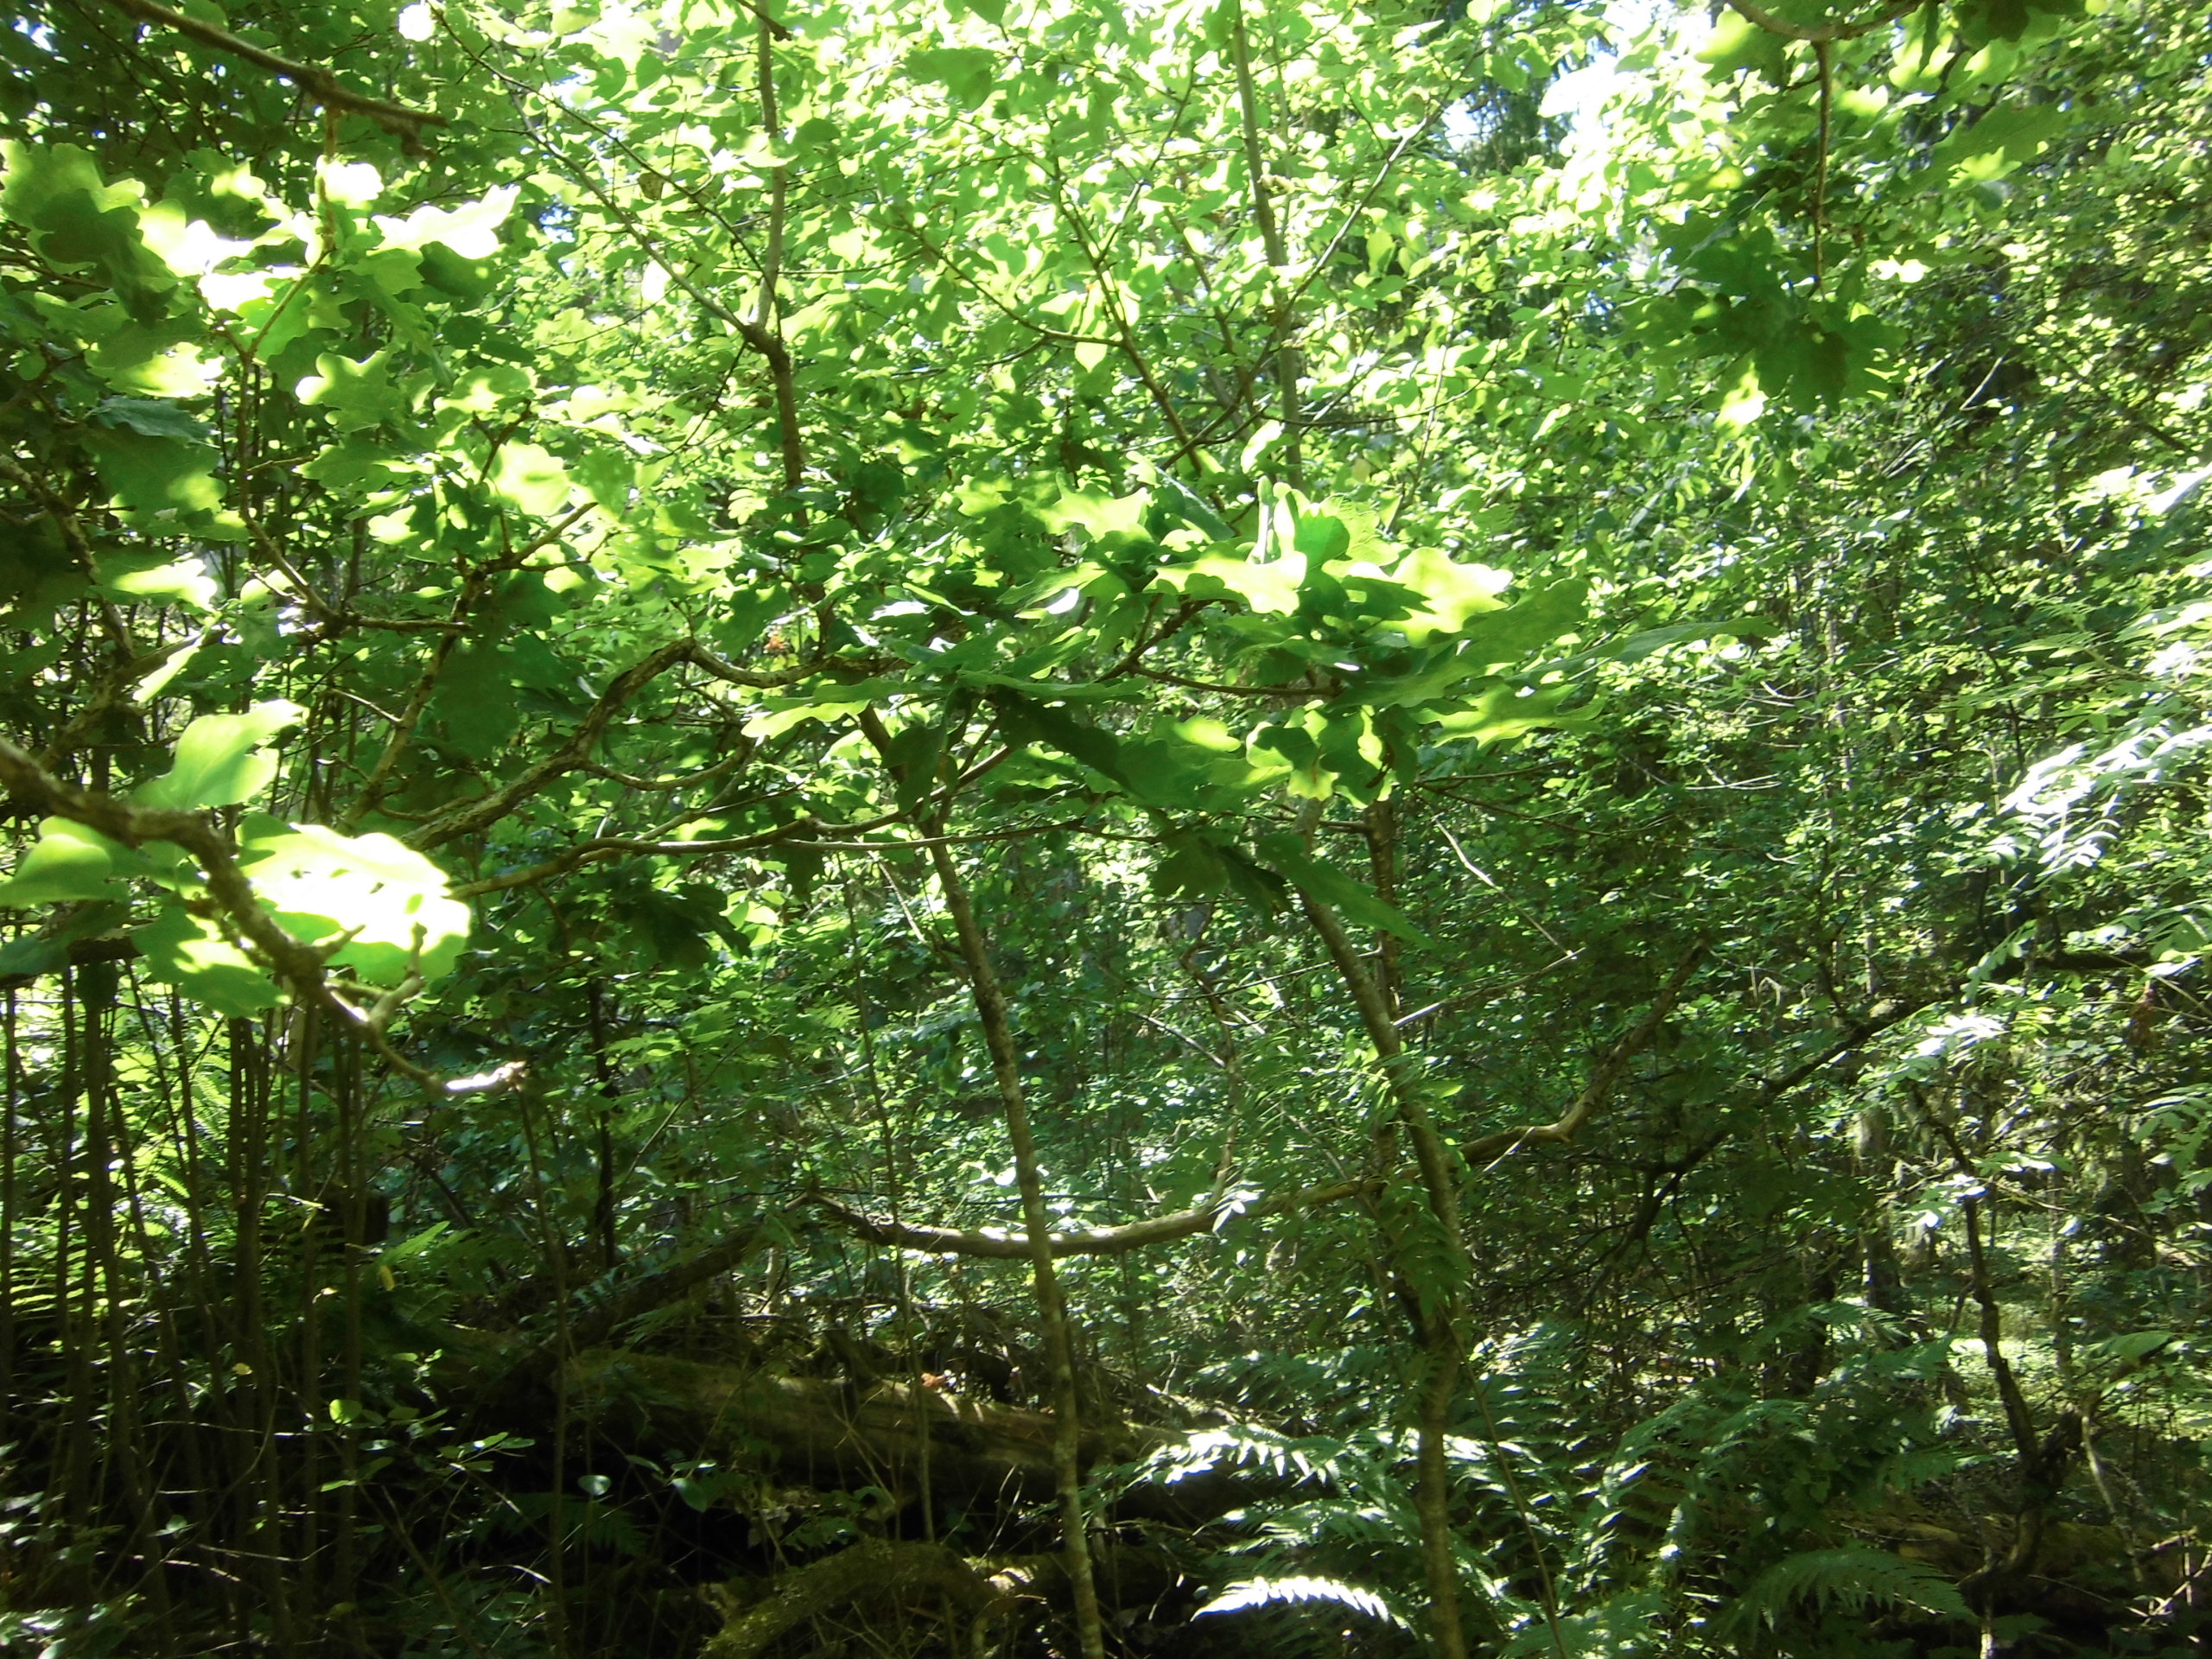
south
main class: Woodland
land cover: Spruce dominated mixed woodland
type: boreal forest
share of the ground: > 75 %
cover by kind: broadleaved forest trees 45 %, coniferous forest trees 30 %, herbaceous plants 15 %, shrubs 5 %, lichens and mosses 5 %
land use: Forestry
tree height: > 5 m
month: July
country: SE
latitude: 57.3413
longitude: 15.2638
